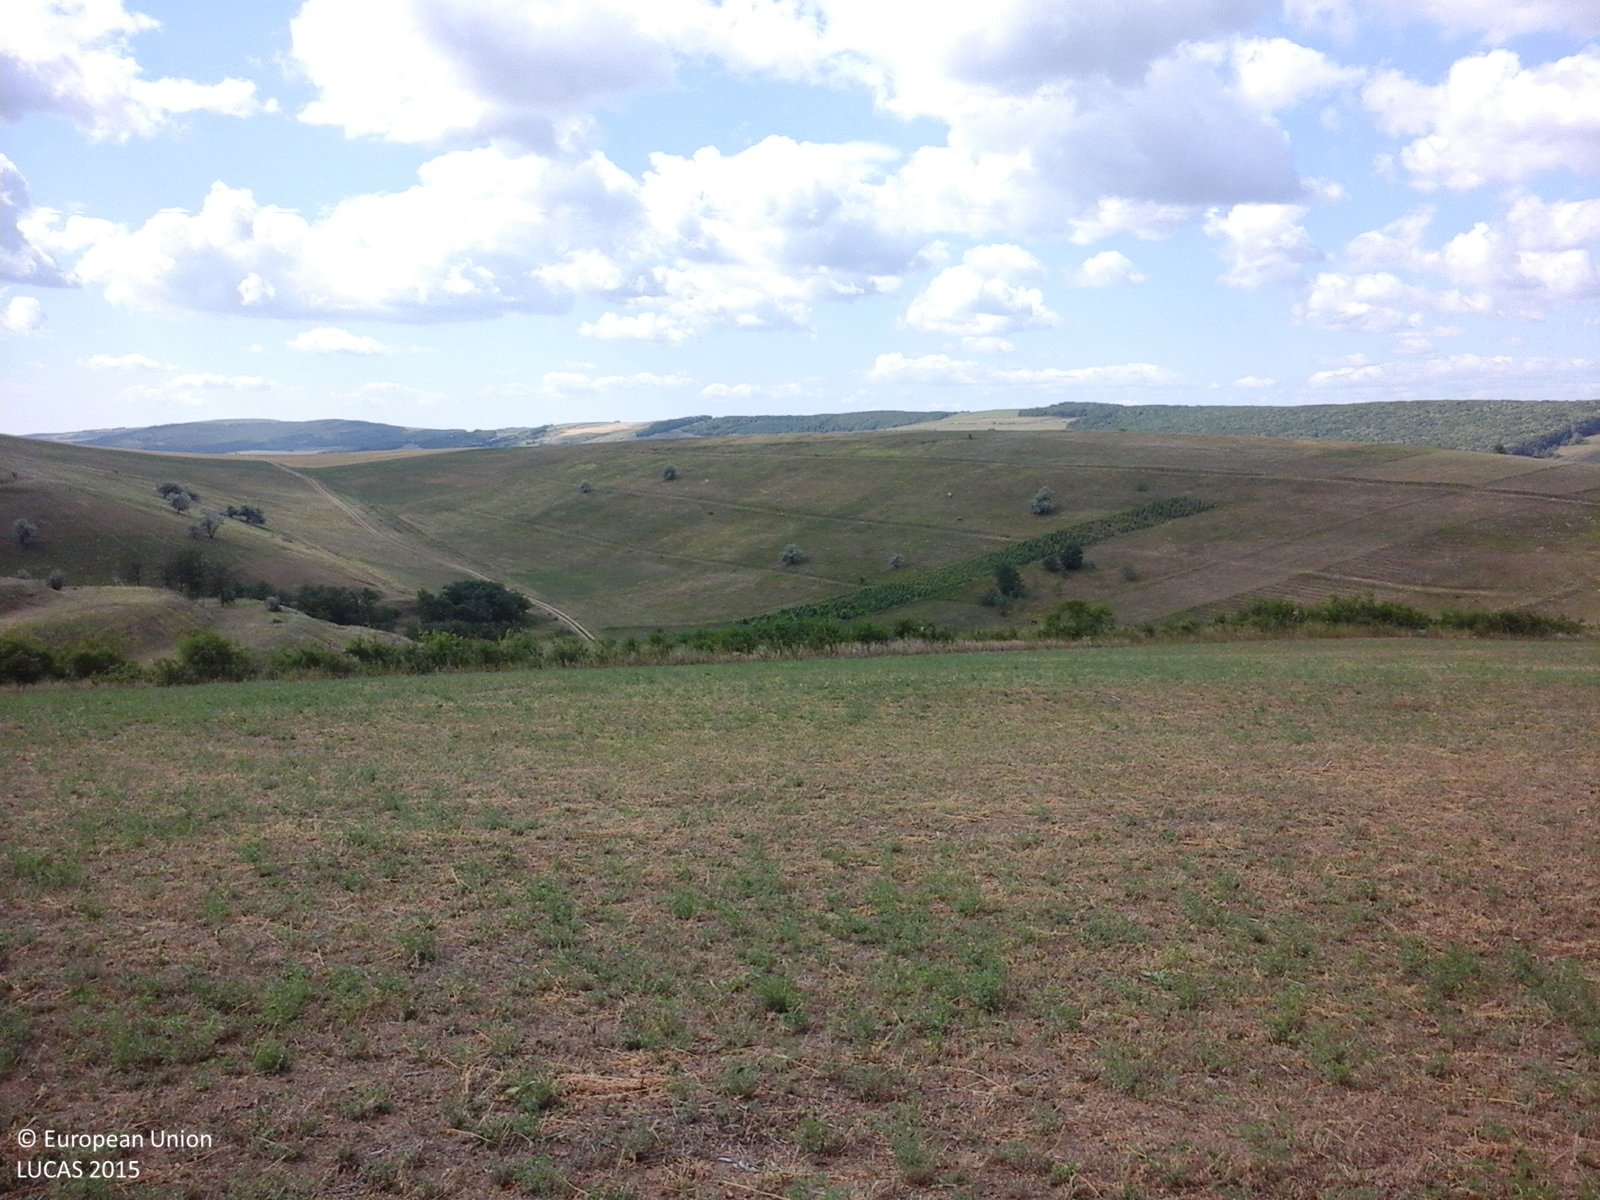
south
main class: Grassland
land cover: Grassland without tree/shrub cover
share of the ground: 10 - 25 %
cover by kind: herbaceous plants 100 %
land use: Agriculture (excluding fallow land and kitchen gardens)
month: July
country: RO
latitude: 46.4156
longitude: 27.3170
